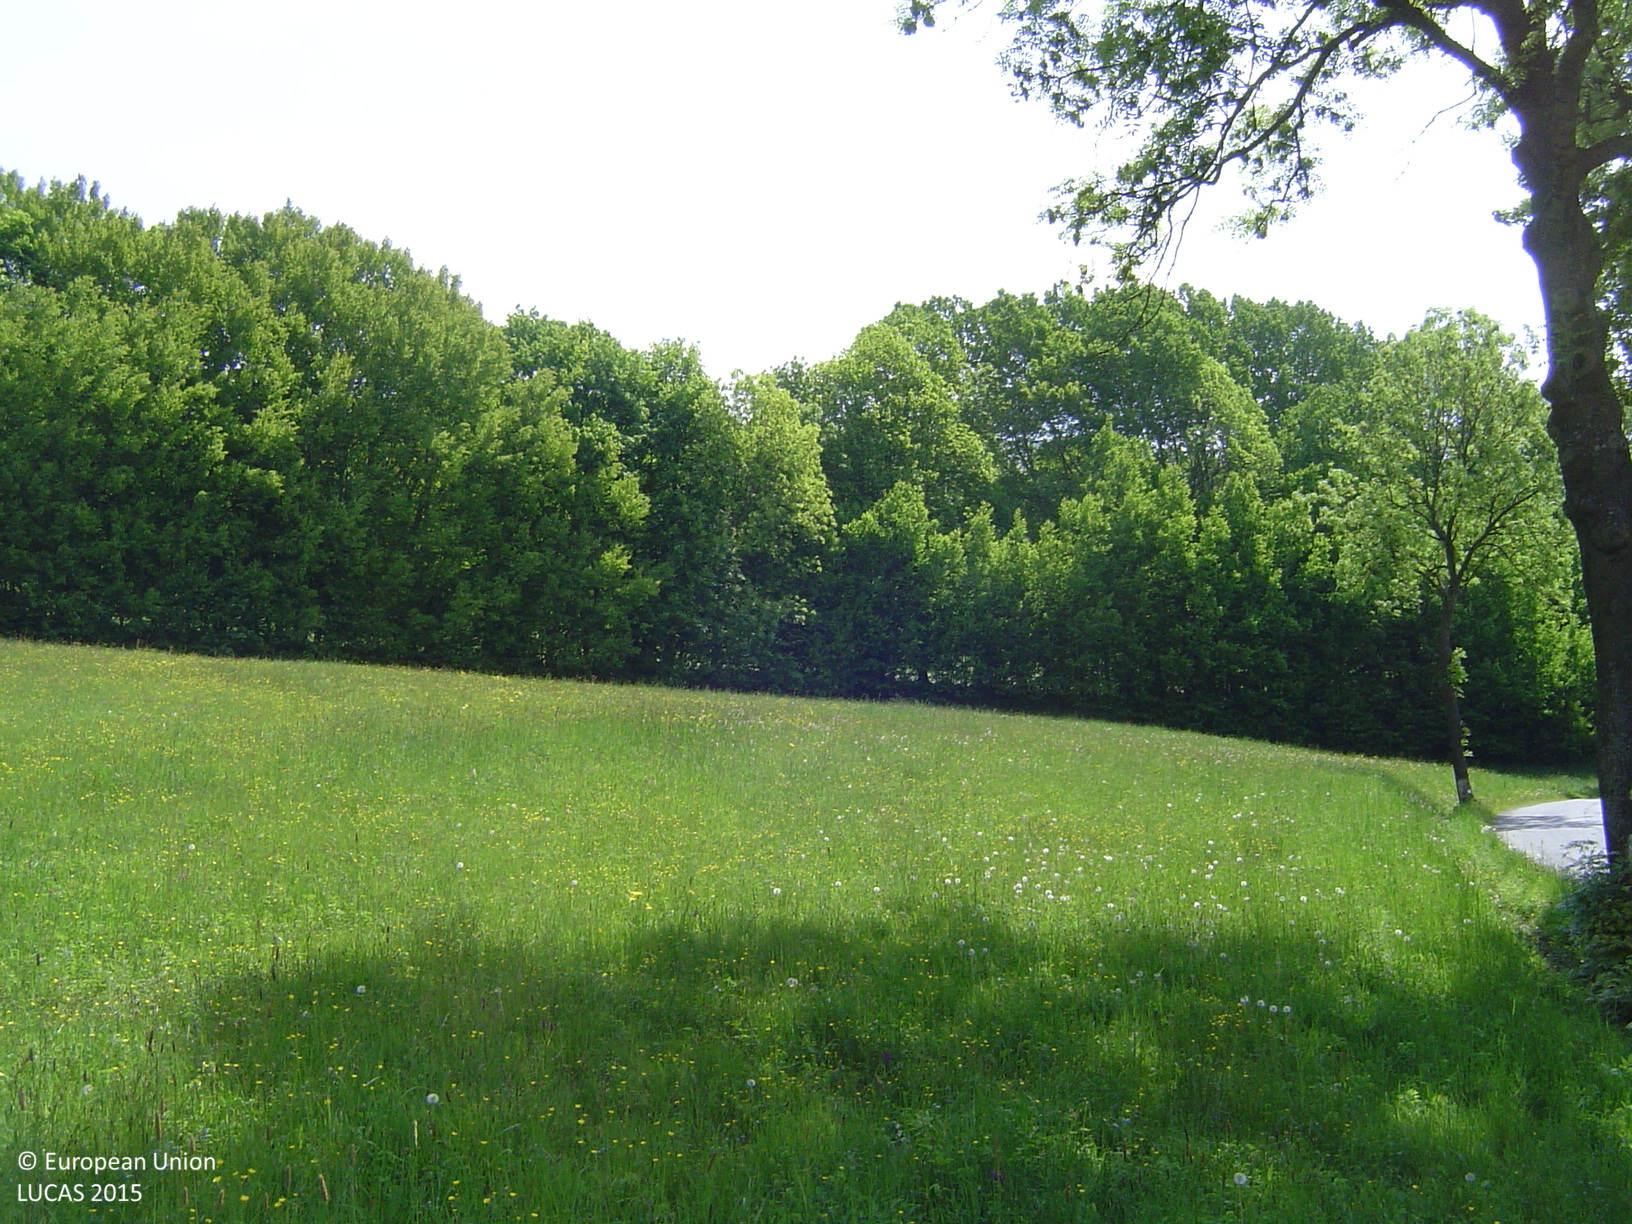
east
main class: Grassland
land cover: Grassland without tree/shrub cover
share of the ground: > 75 %
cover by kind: herbaceous plants 100 %
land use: Agriculture (excluding fallow land and kitchen gardens)
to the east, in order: Grassland without tree/shrub cover; Broadleaved woodland; Grassland without tree/shrub cover; Broadleaved woodland; Grassland without tree/shrub cover; Broadleaved woodland
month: May
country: CZ
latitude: 49.5966
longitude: 16.2738
